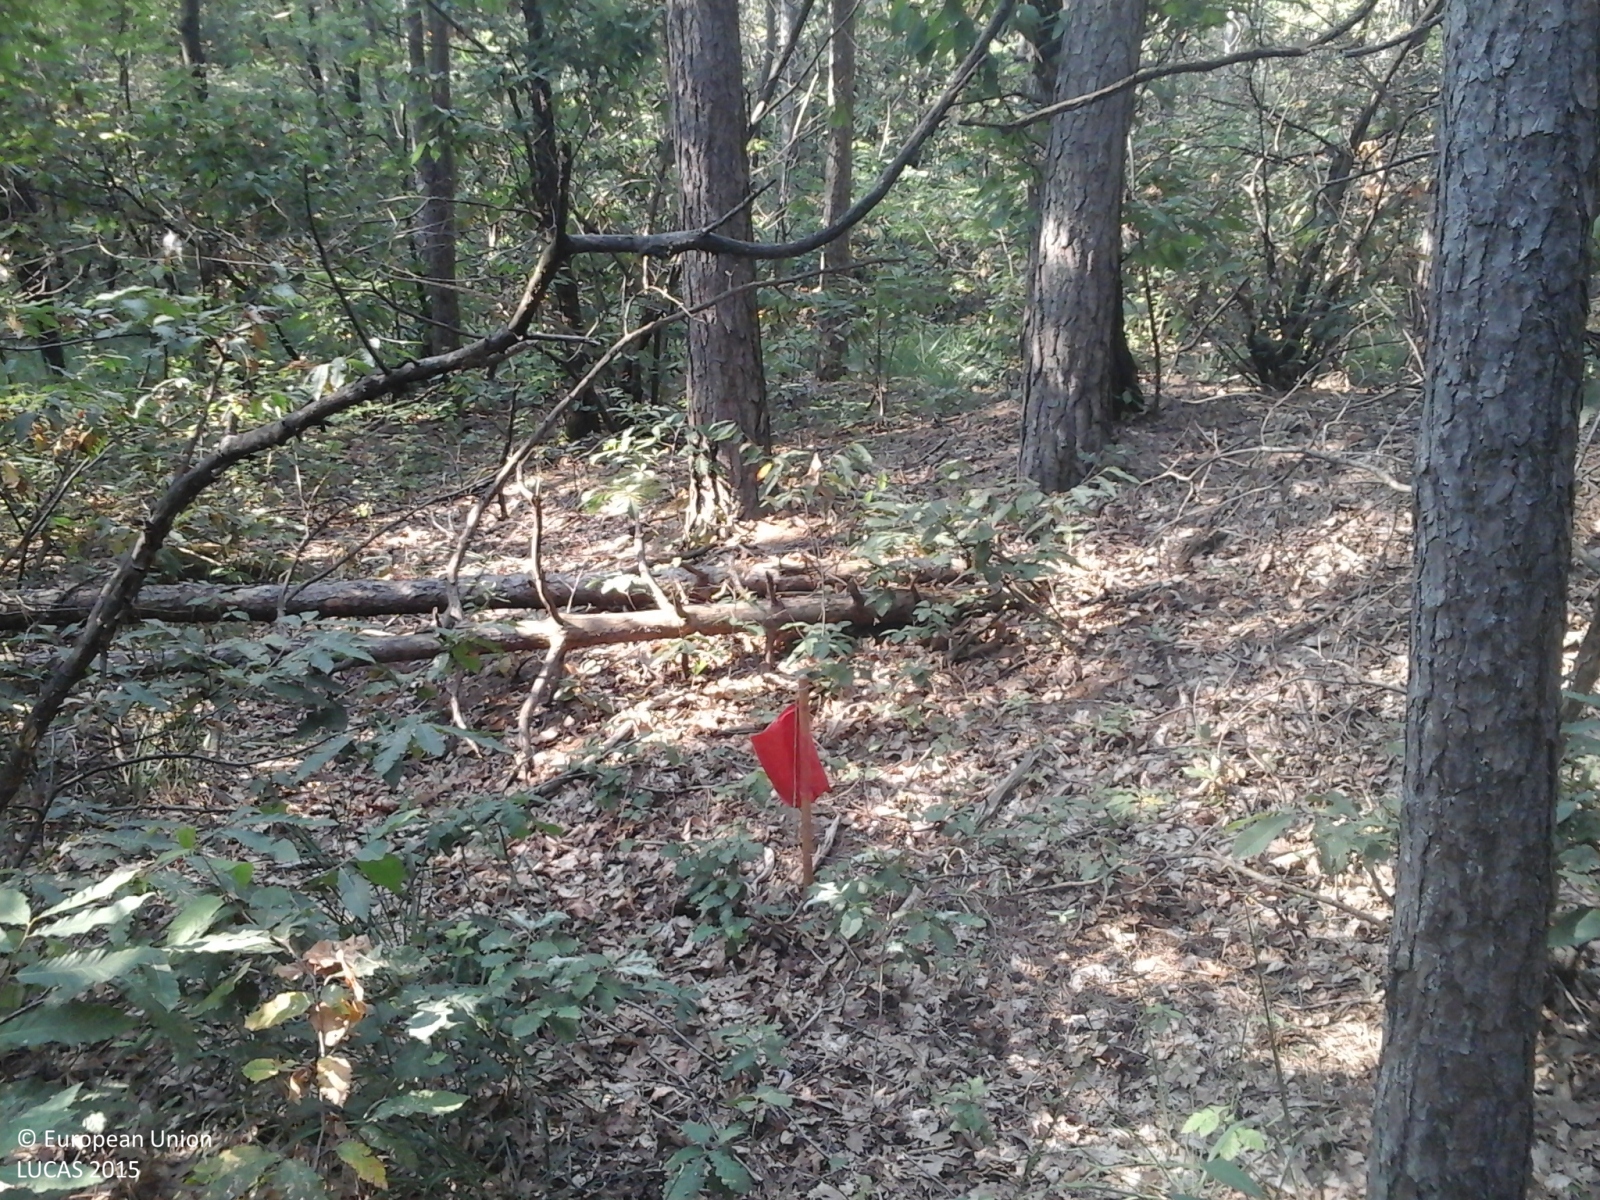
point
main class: Woodland
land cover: Pine dominated mixed woodland
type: thermophilous deciduous forest
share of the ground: > 75 %
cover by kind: coniferous forest trees 50 %, broadleaved forest trees 50 %
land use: Forestry
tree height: > 5 m
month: July
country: IT
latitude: 45.7516
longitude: 8.9604
